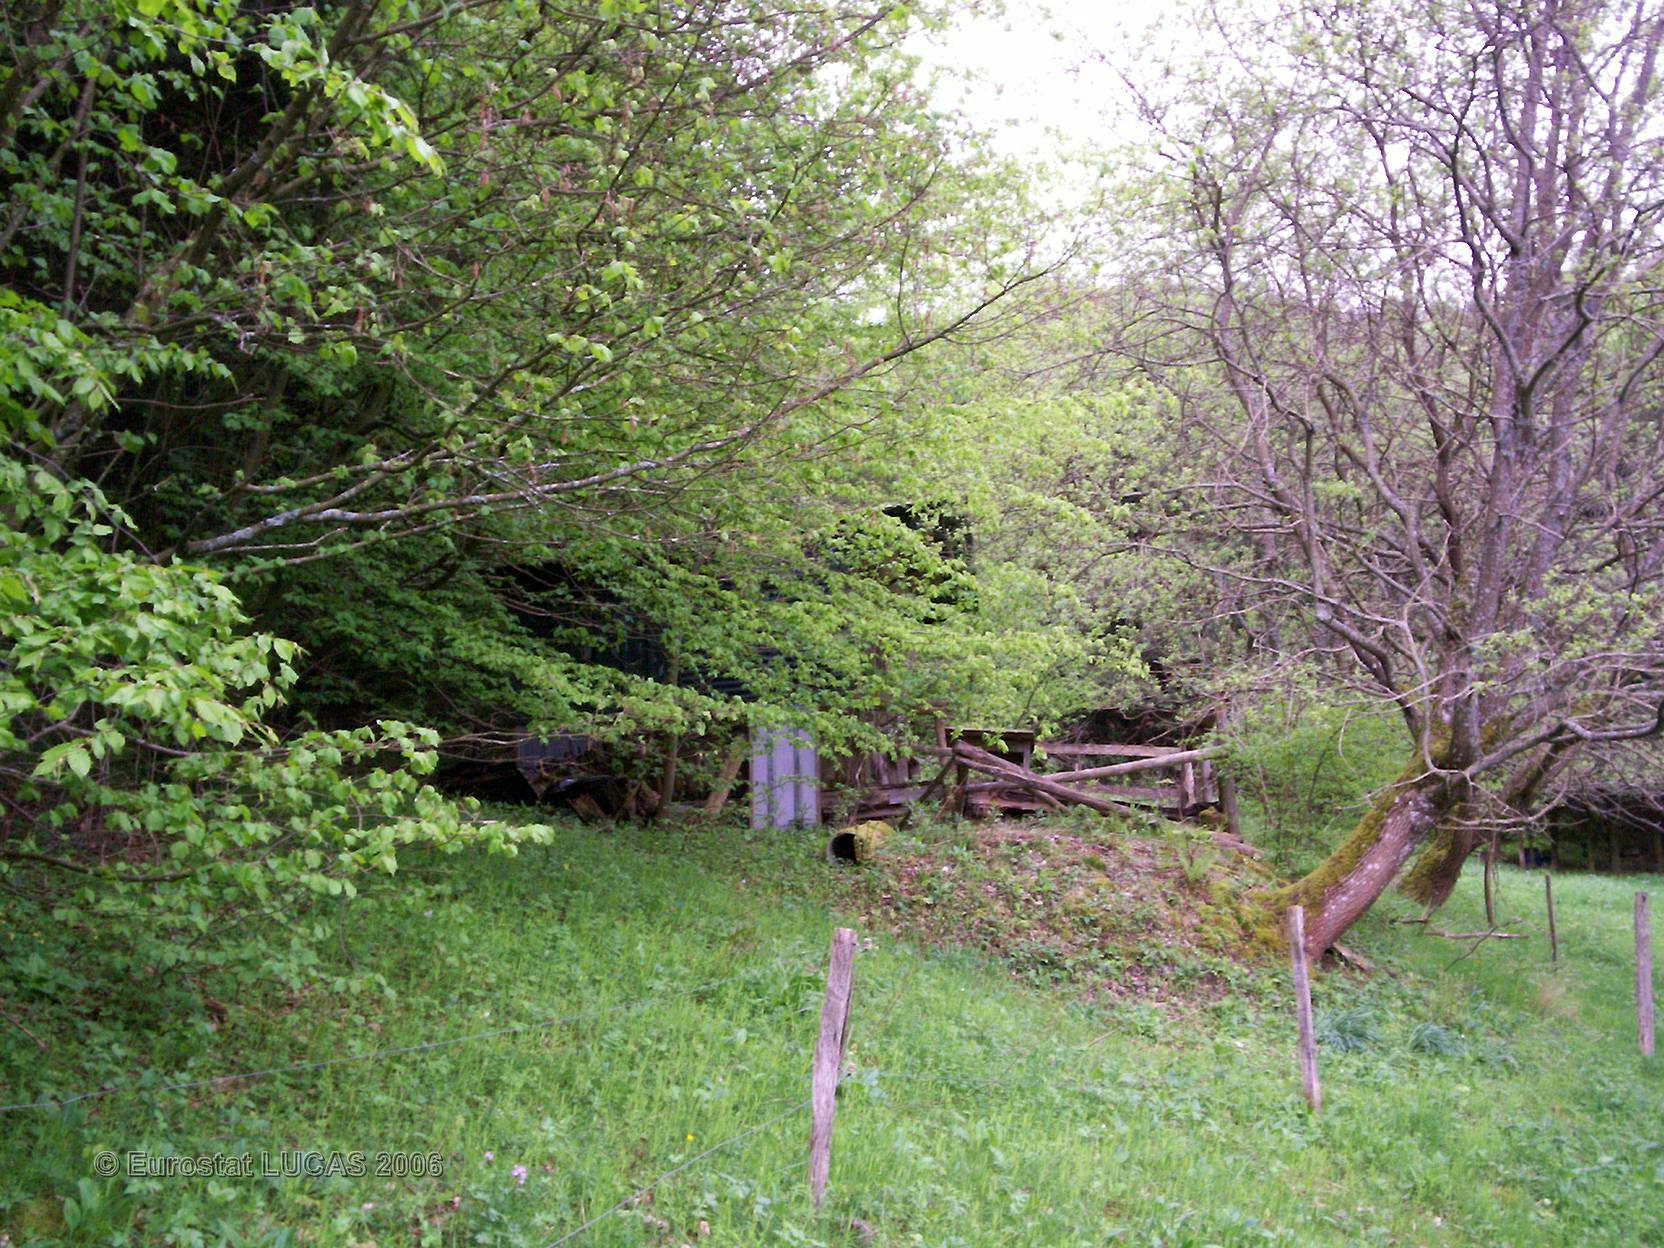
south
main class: Grassland
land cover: Grassland with sparse tree/shrub cover
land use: Agriculture (excluding fallow land and kitchen gardens)
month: May
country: FR
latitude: 47.8987
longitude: 7.1521
